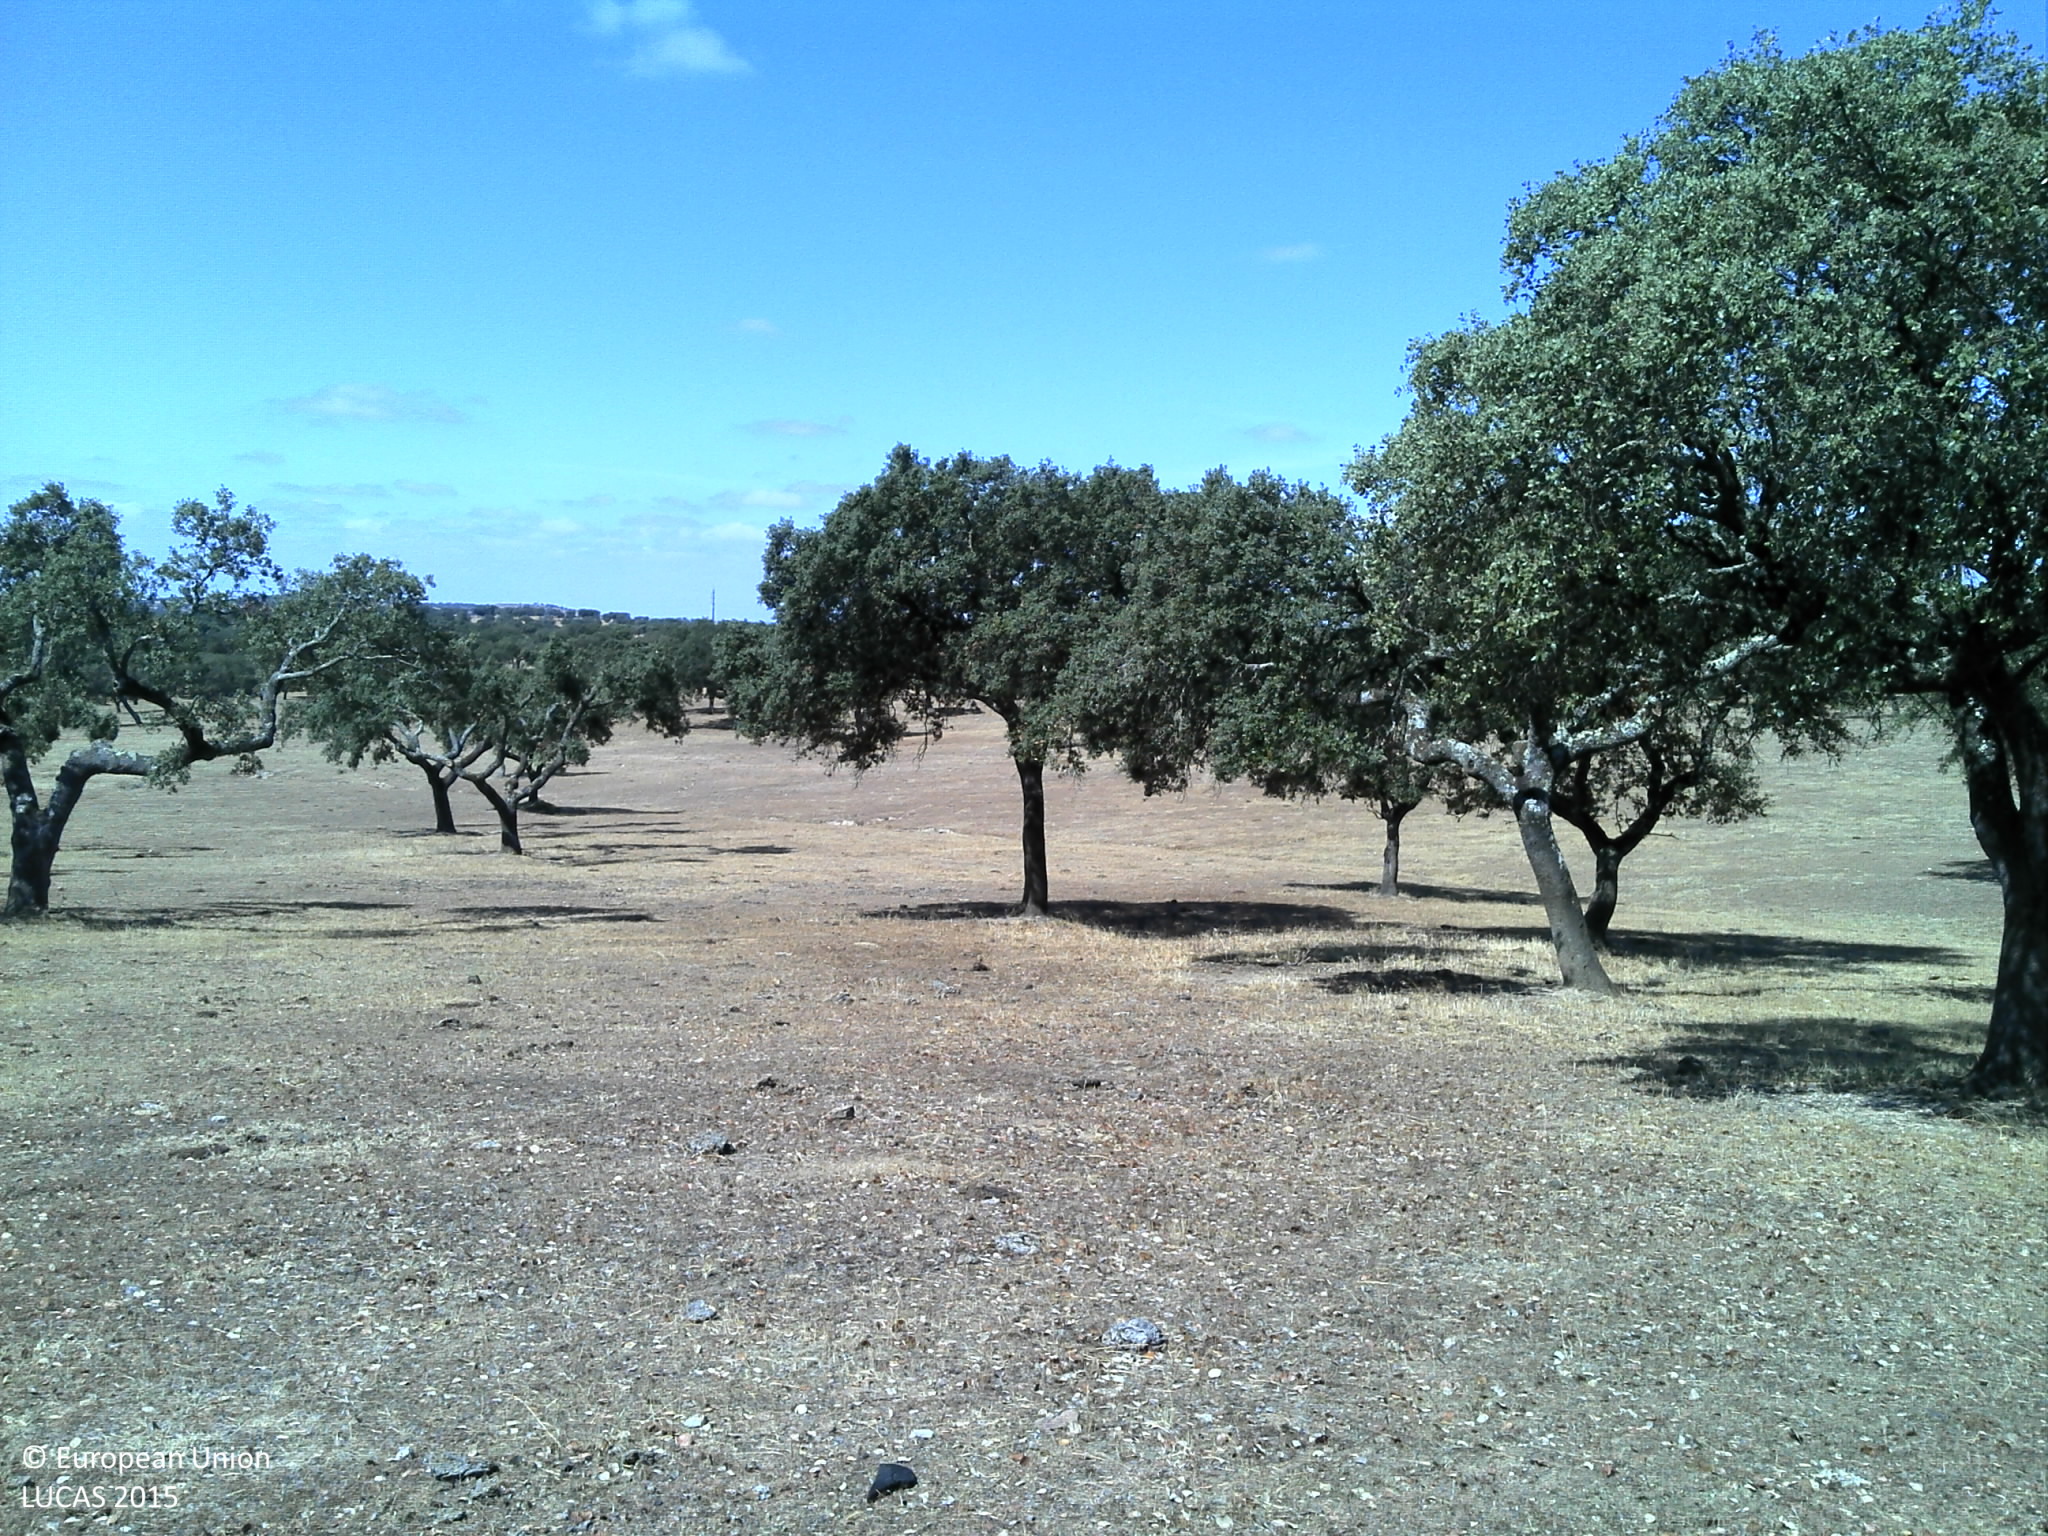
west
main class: Woodland
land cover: Broadleaved woodland
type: broadleaved evergreen forest
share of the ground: 10 - 25 %
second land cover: Grassland without tree/shrub cover
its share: < 10 %
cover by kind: unconsolidated bare surface 80 %, broadleaved forest trees 10 %, herbaceous plants 10 %
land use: Forestry
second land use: Agriculture (excluding fallow land and kitchen gardens)
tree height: > 5 m
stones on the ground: < 10 %
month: June
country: PT
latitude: 38.2963
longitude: -8.0699
